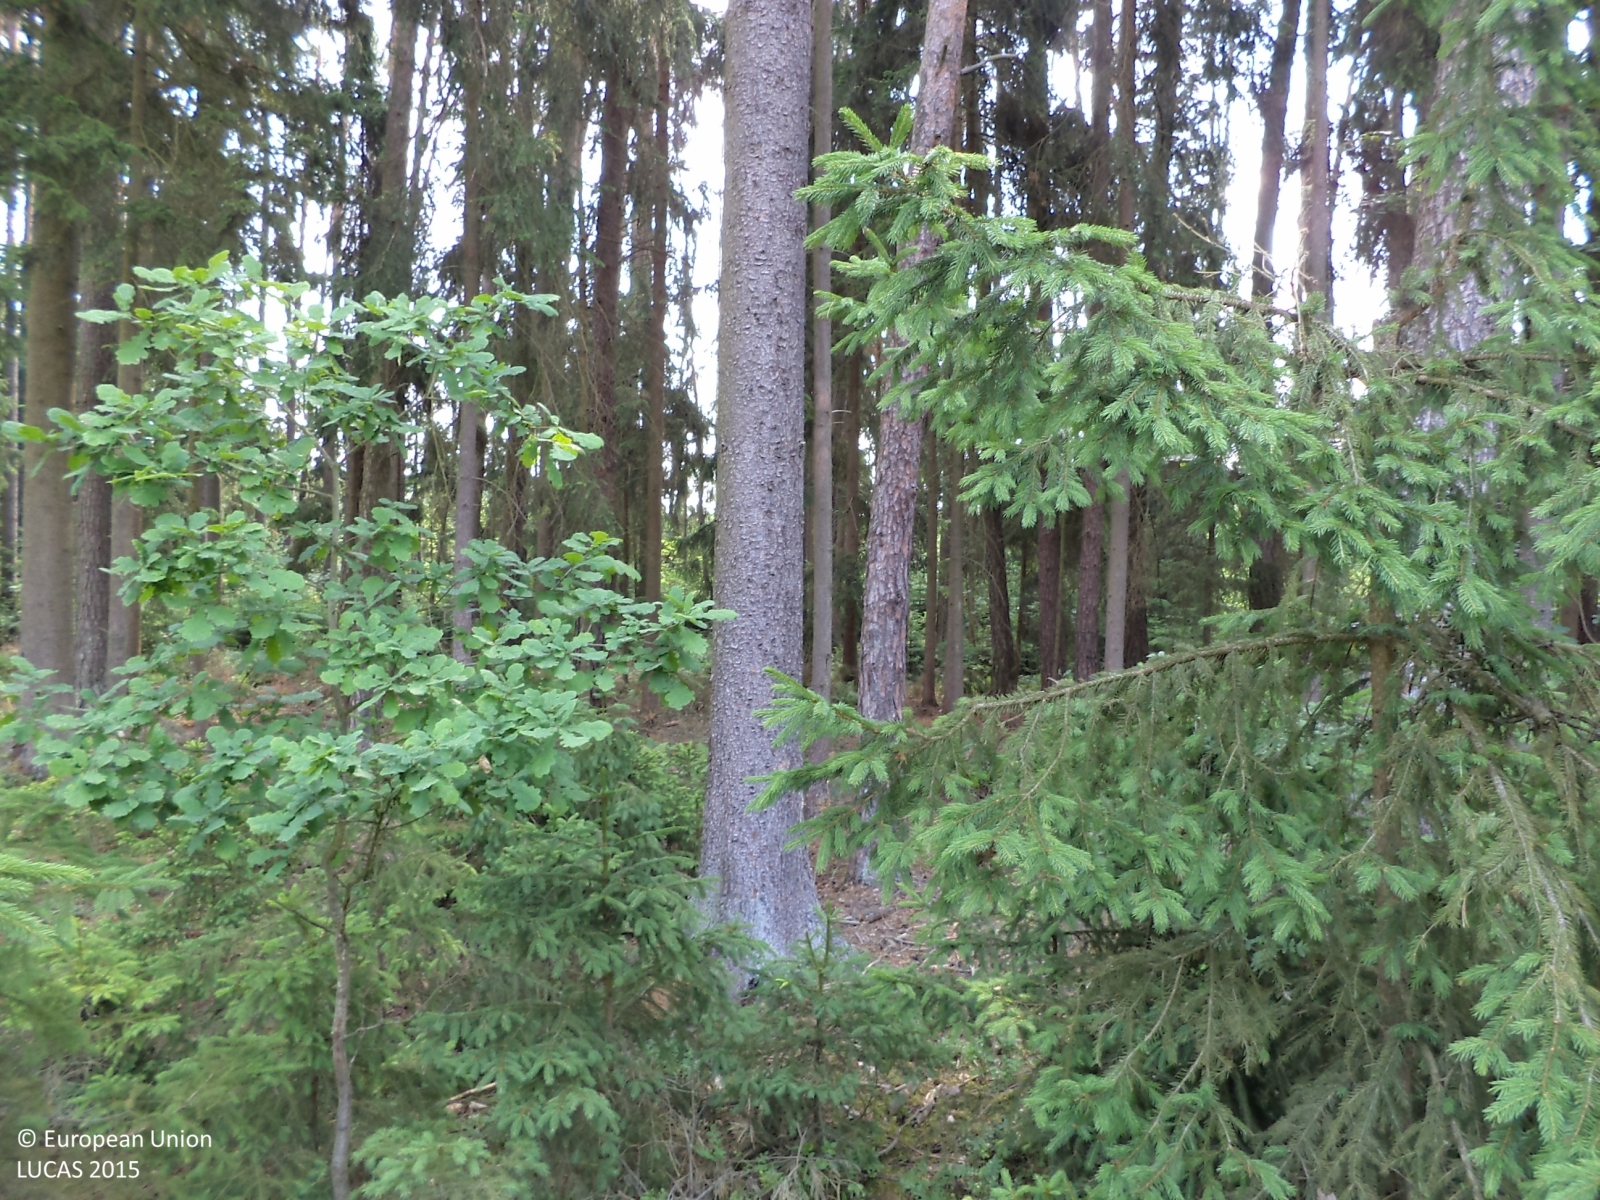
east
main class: Woodland
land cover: Pine dominated coniferous woodland
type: hemiboreal forest and nemoral coniferous forest and mixed broadleaved-coniferous forest
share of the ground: > 75 %
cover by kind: coniferous forest trees 90 %, herbaceous plants 10 %
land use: Forestry
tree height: > 5 m
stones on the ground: < 10 %
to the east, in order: Pine dominated coniferous woodland; Tracks; Broadleaved woodland; Spruce dominated coniferous woodland; Spruce dominated mixed woodland; Tracks; Spruce dominated mixed woodland; Pine dominated mixed woodland; Spruce dominated mixed woodland
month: July
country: CZ
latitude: 49.3780
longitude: 14.4226
